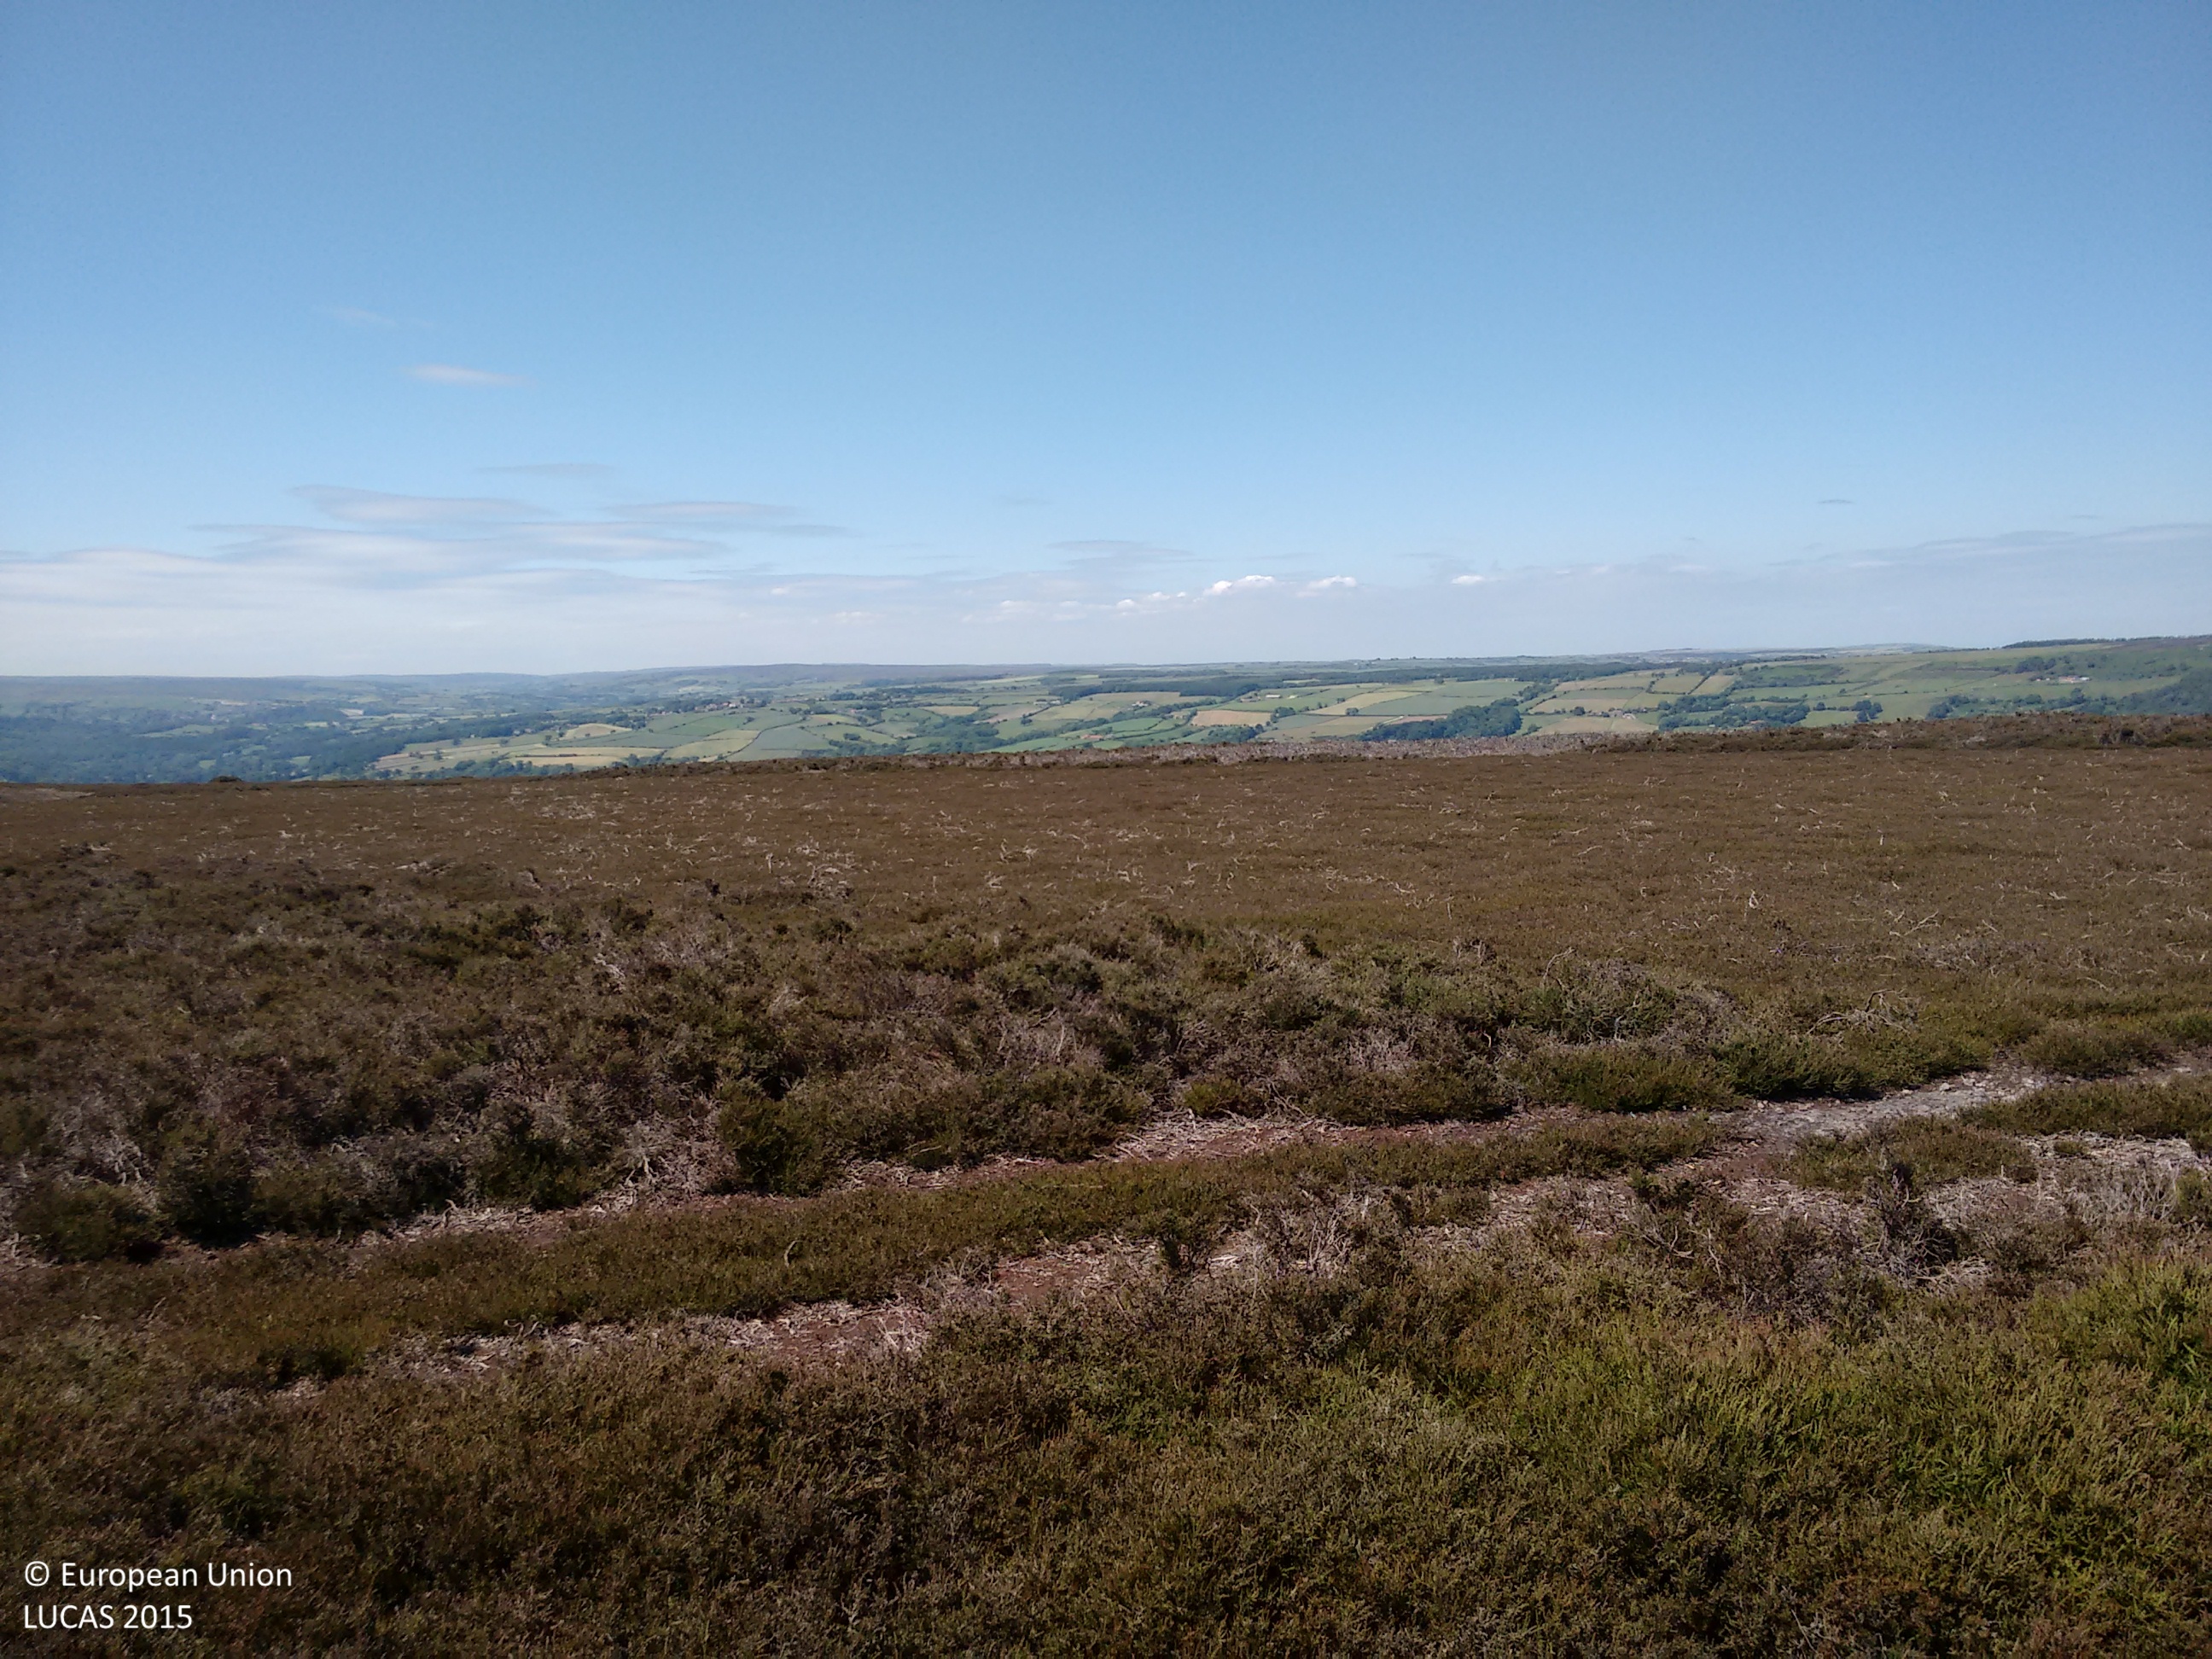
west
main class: Shrubland
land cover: Shrubland without tree cover
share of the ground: > 75 %
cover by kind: shrubs 90 %, herbaceous plants 10 %
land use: Agriculture (excluding fallow land and kitchen gardens)
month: June
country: GB
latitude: 54.4331
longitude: -0.6906
